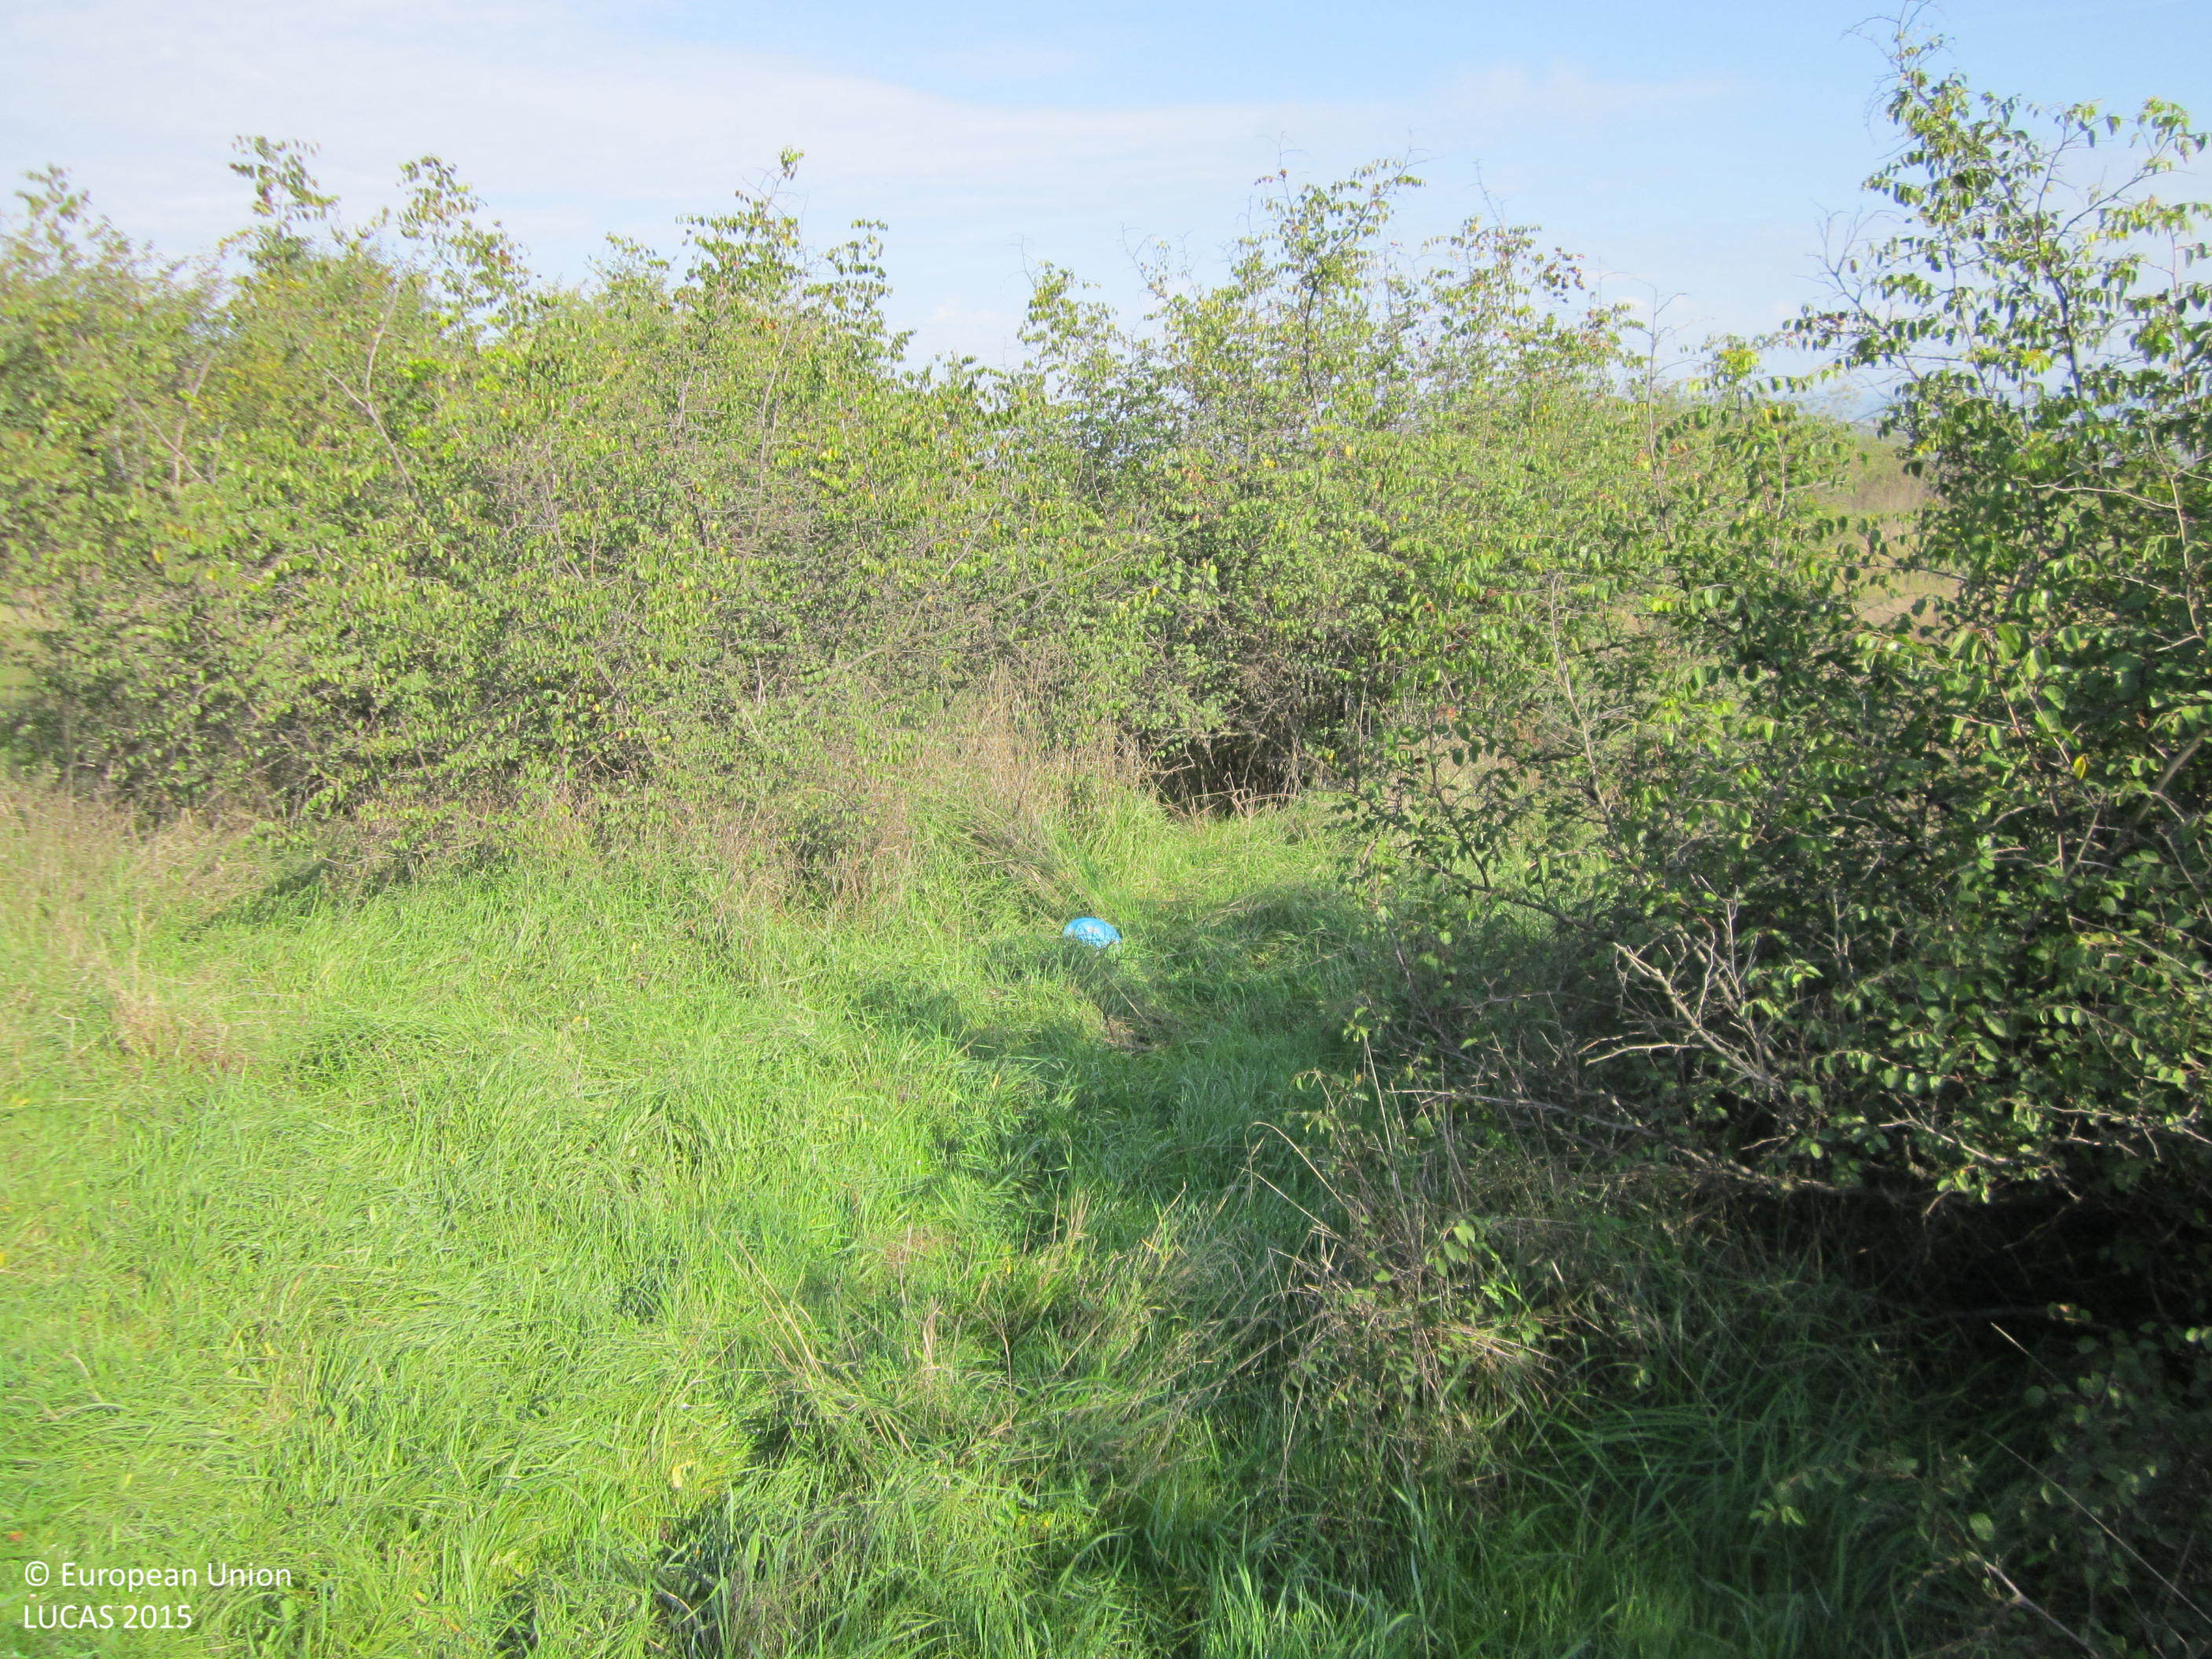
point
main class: Shrubland
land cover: Shrubland without tree cover
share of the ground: 25 - 50 %
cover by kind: herbaceous plants 55 %, shrubs 45 %
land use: Semi-natural and natural areas not in use
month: October
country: BG
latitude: 42.6829
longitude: 26.8598
